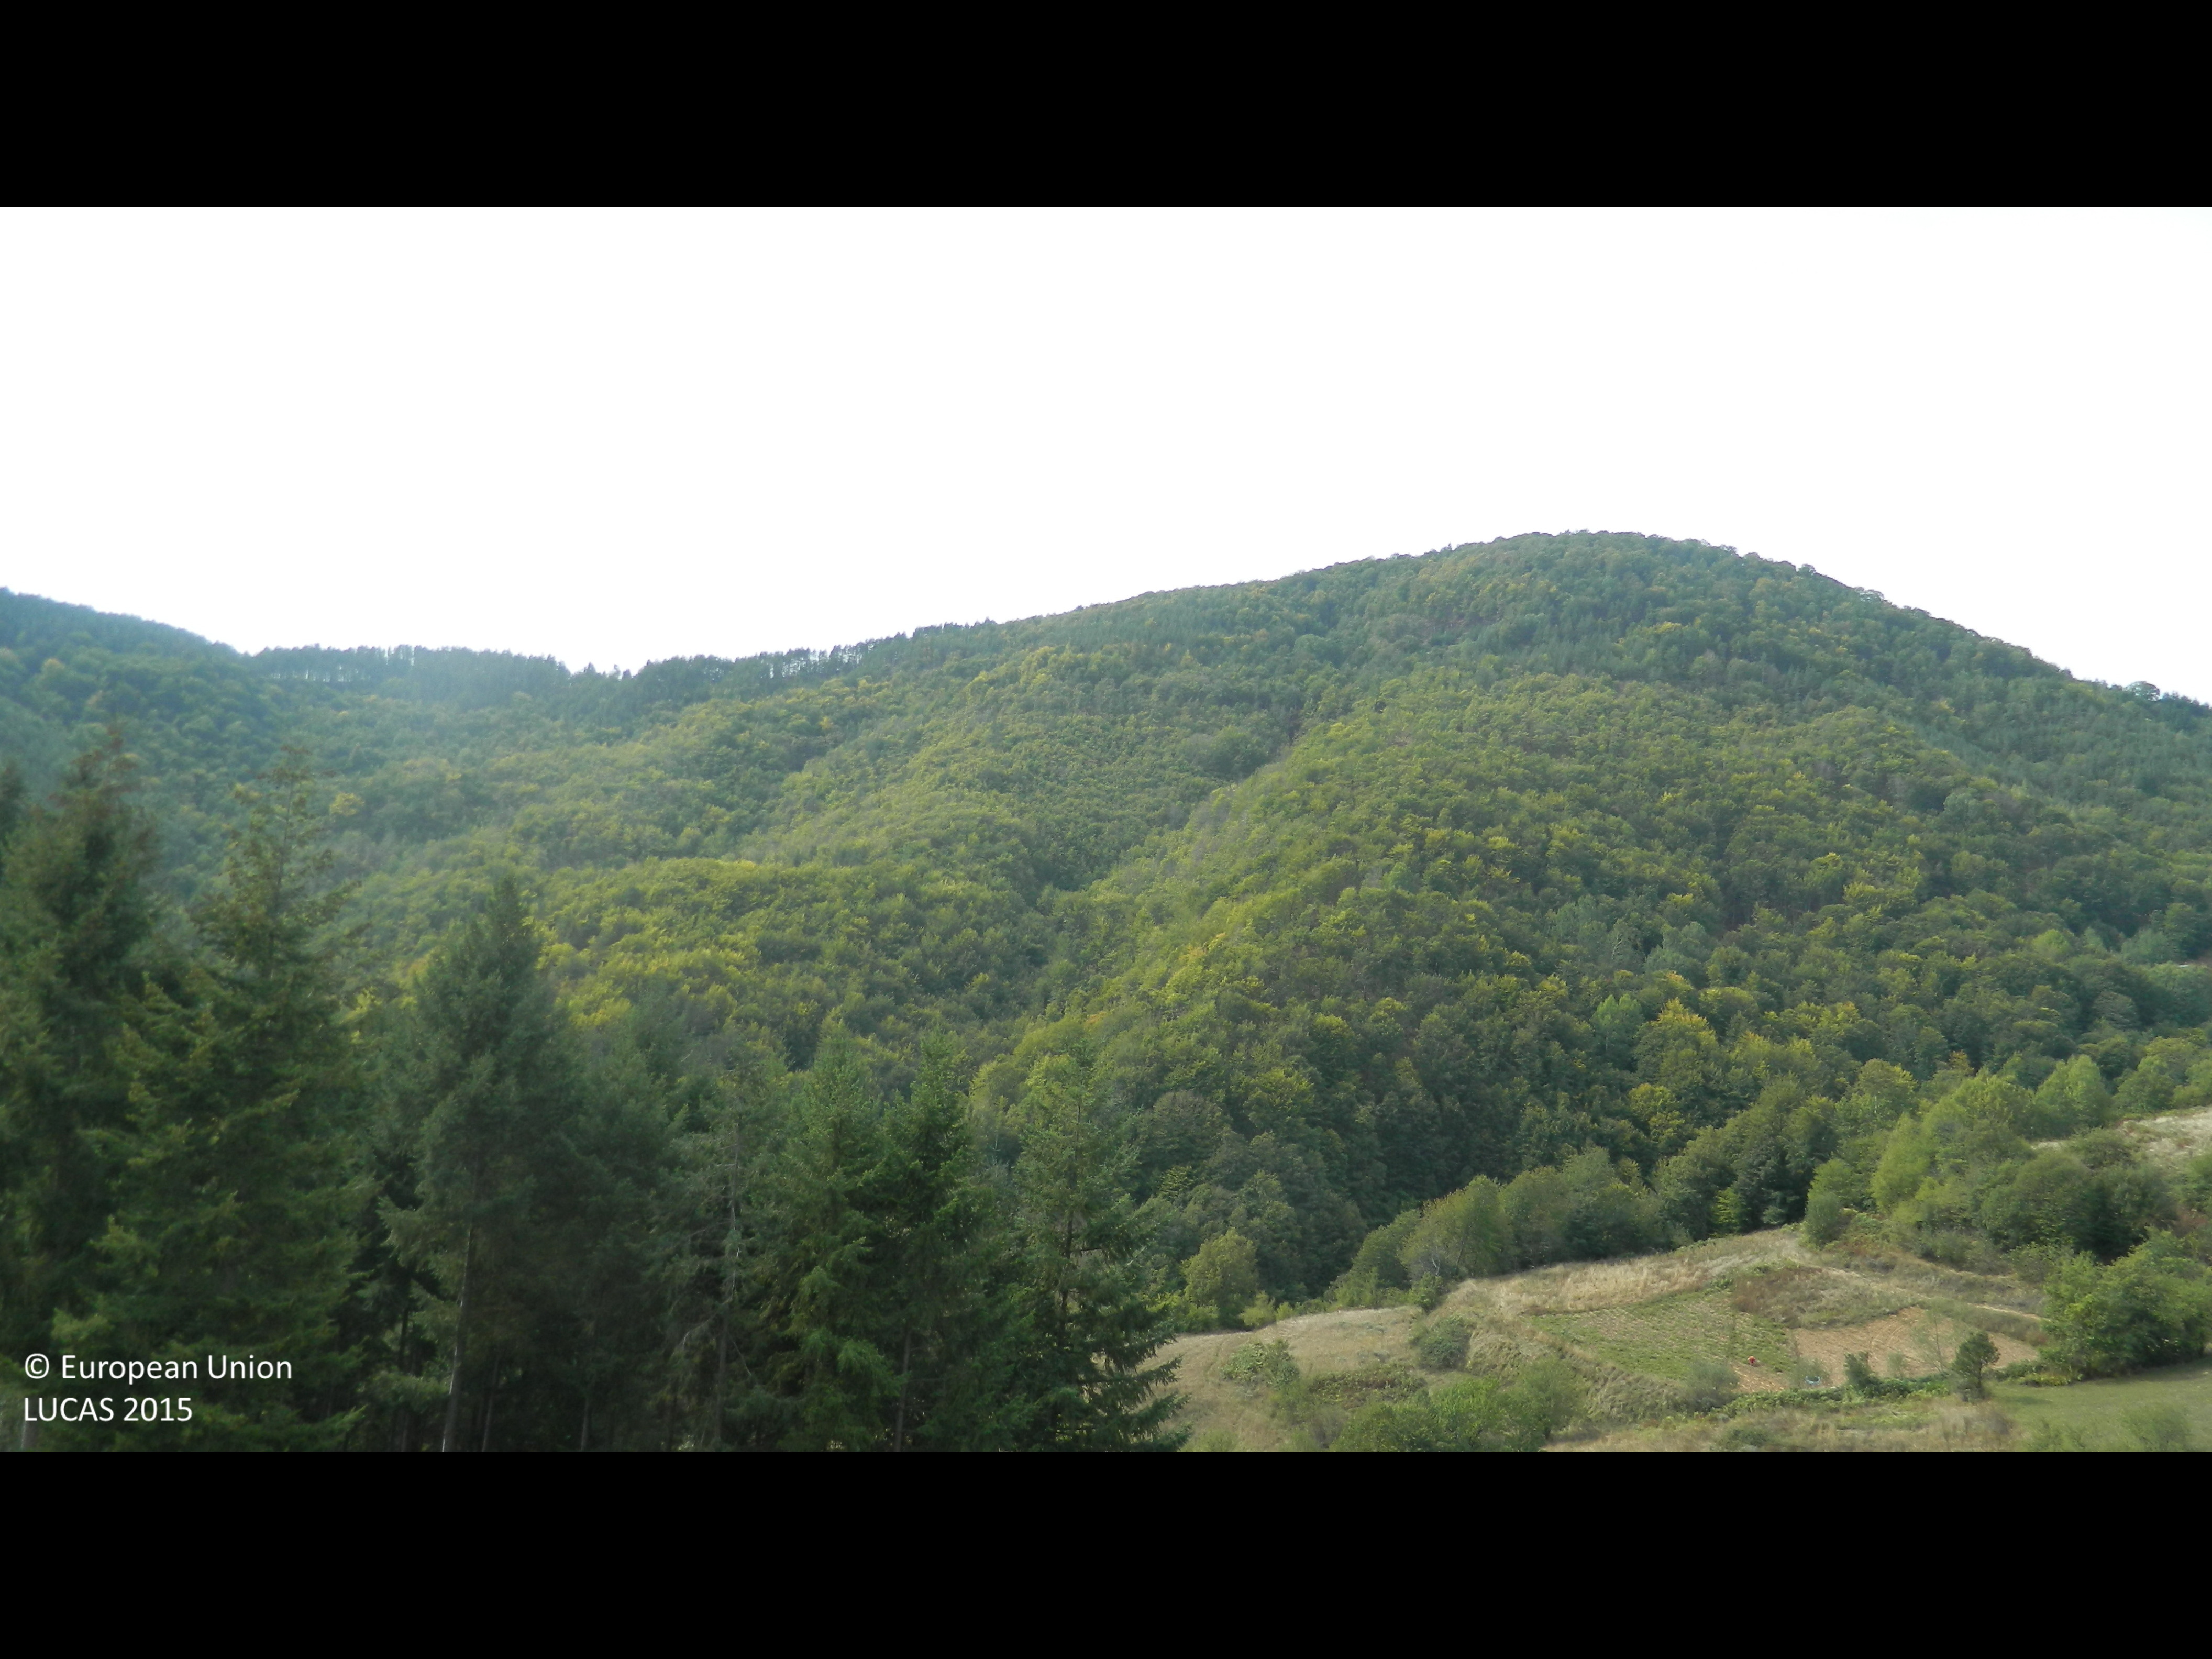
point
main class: Woodland
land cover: Pine dominated mixed woodland
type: hemiboreal forest and nemoral coniferous forest and mixed broadleaved-coniferous forest
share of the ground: > 75 %
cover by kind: coniferous forest trees 75 %, broadleaved forest trees 25 %
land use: Forestry
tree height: > 5 m
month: October
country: BG
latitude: 41.5838
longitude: 24.8848
